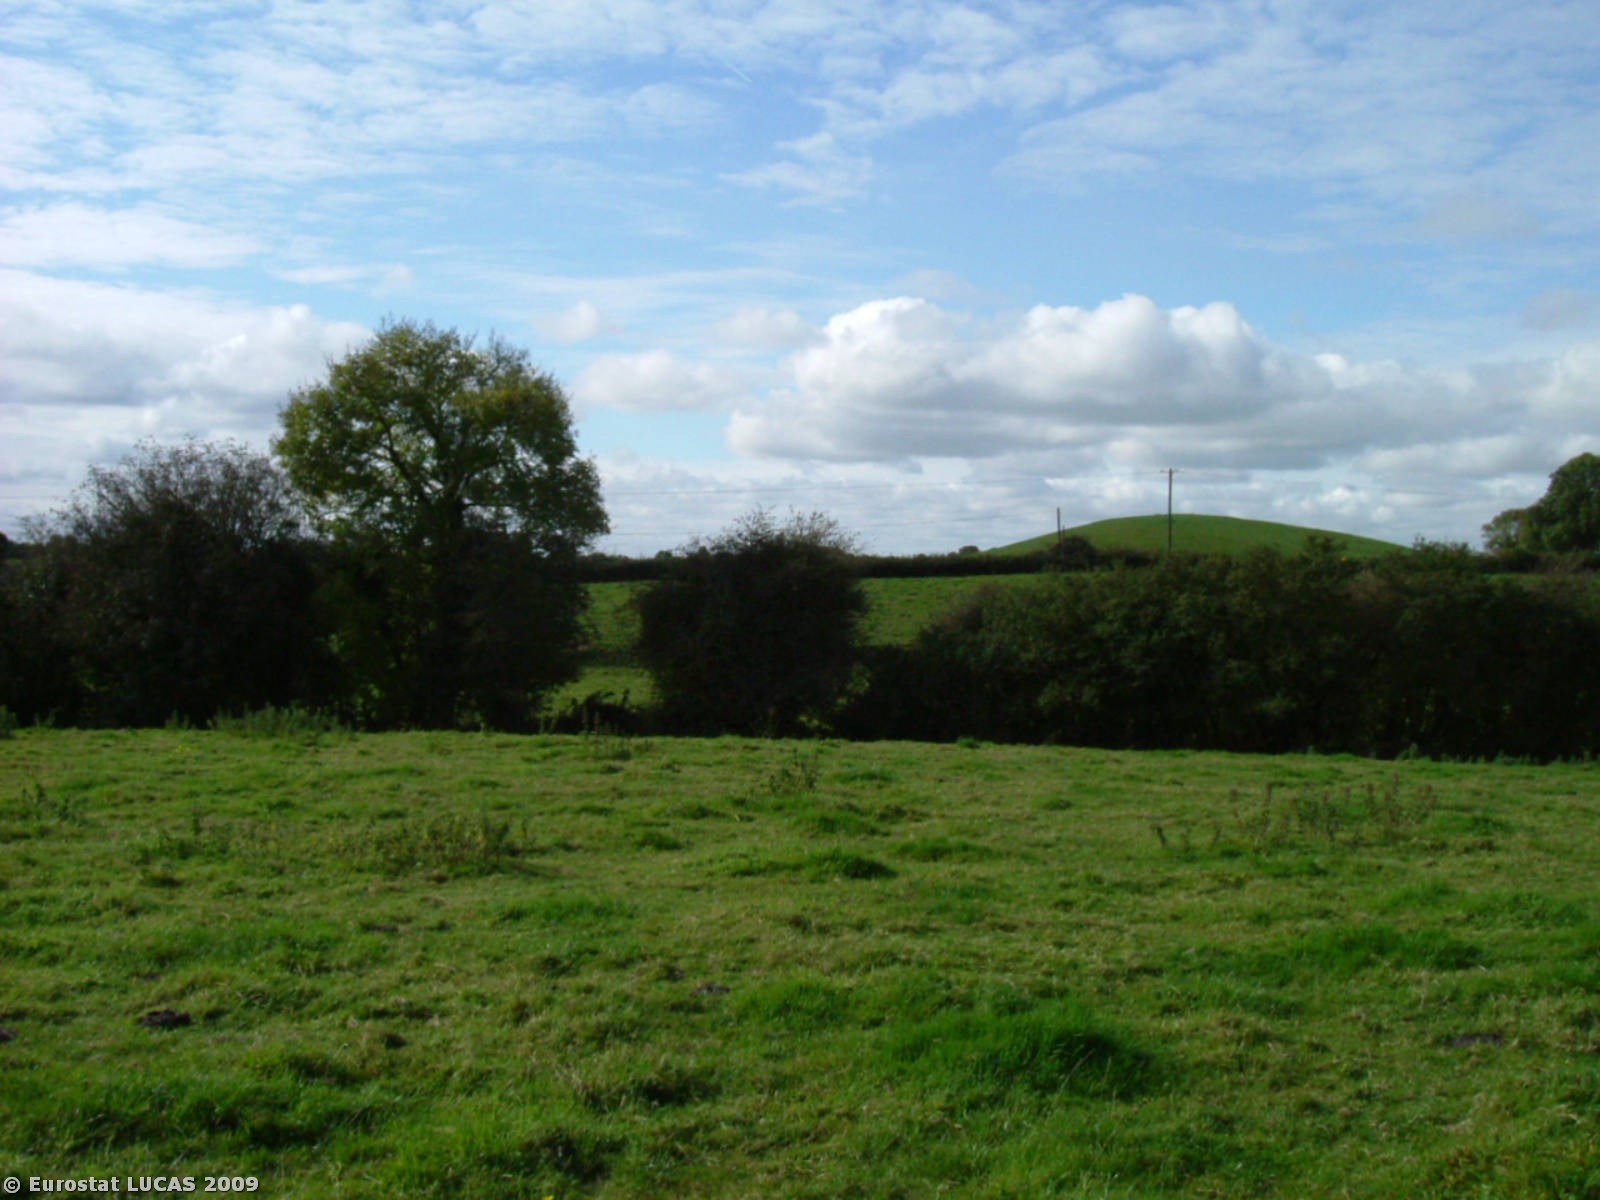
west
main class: Grassland
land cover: Grassland without tree/shrub cover
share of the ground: > 75 %
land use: Agriculture (excluding fallow land and kitchen gardens)
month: October
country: IE
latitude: 52.5558
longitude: -8.1002
